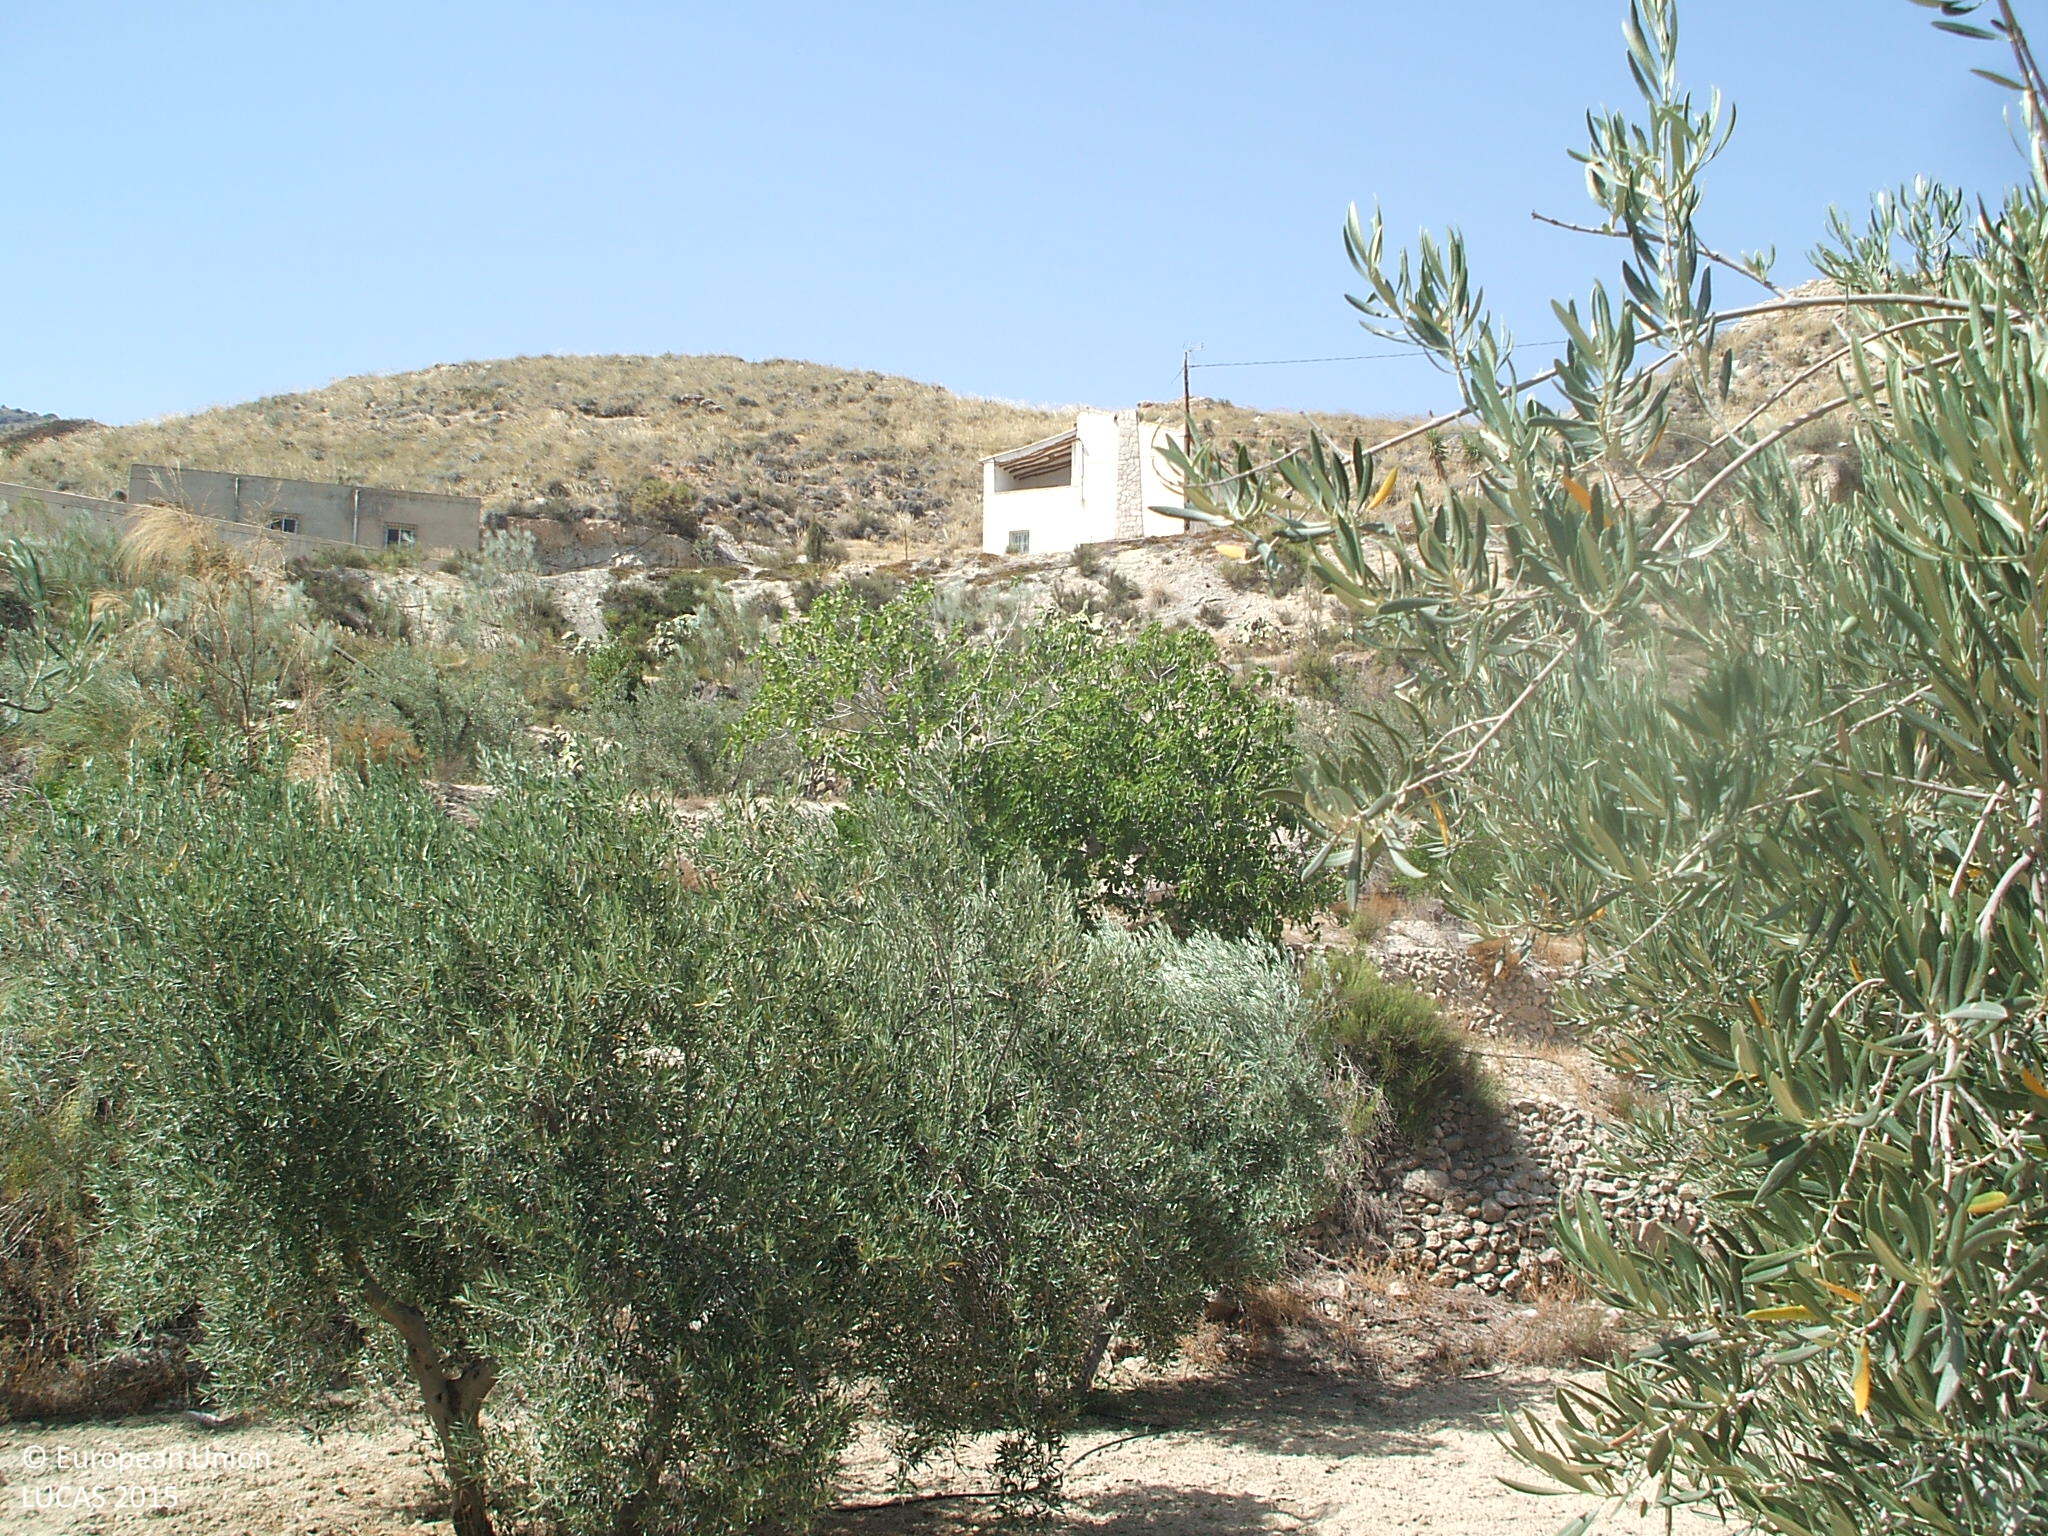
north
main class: Cropland
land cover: Olive groves
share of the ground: 50 - 75 %
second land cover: Other bare soil
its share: > 75 %
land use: Agriculture (excluding fallow land and kitchen gardens)
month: July
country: ES
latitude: 37.3821
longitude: -2.3264
